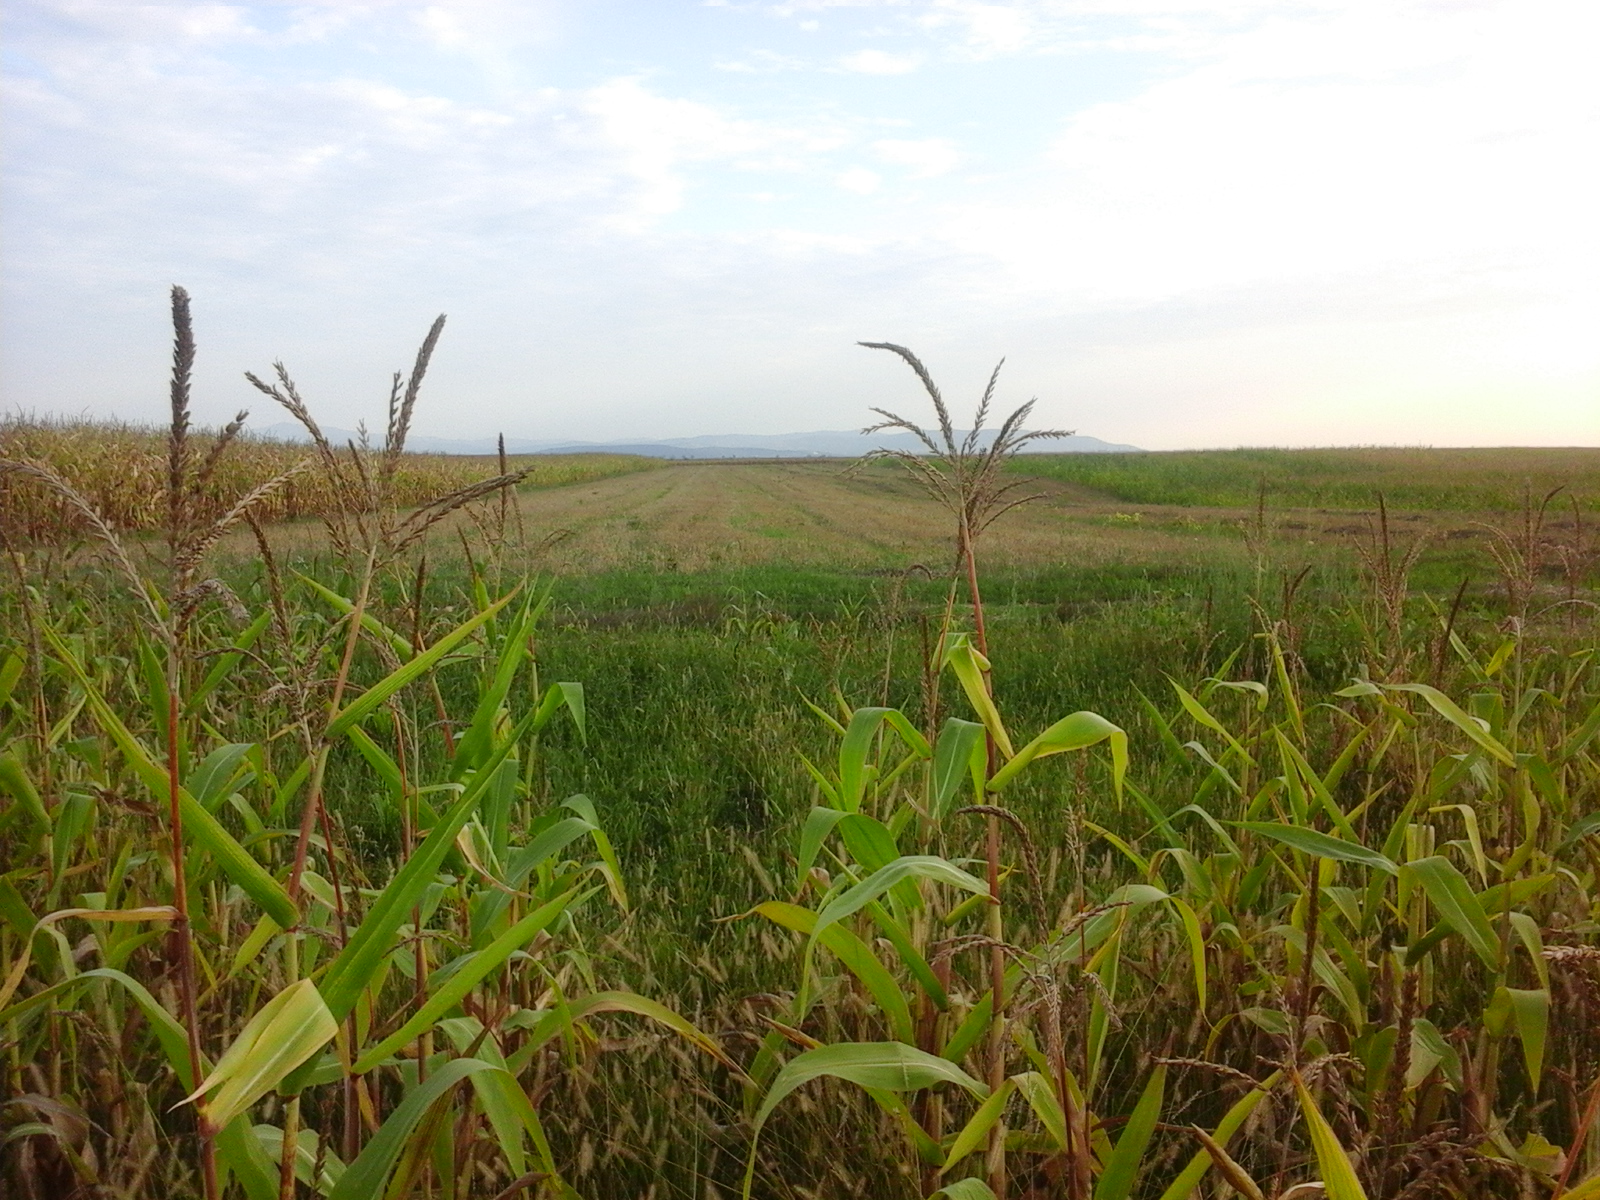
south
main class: Cropland
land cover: Maize
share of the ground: > 75 %
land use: Agriculture (excluding fallow land and kitchen gardens)
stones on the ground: < 10 %
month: August
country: RO
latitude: 46.4505
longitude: 21.7179
